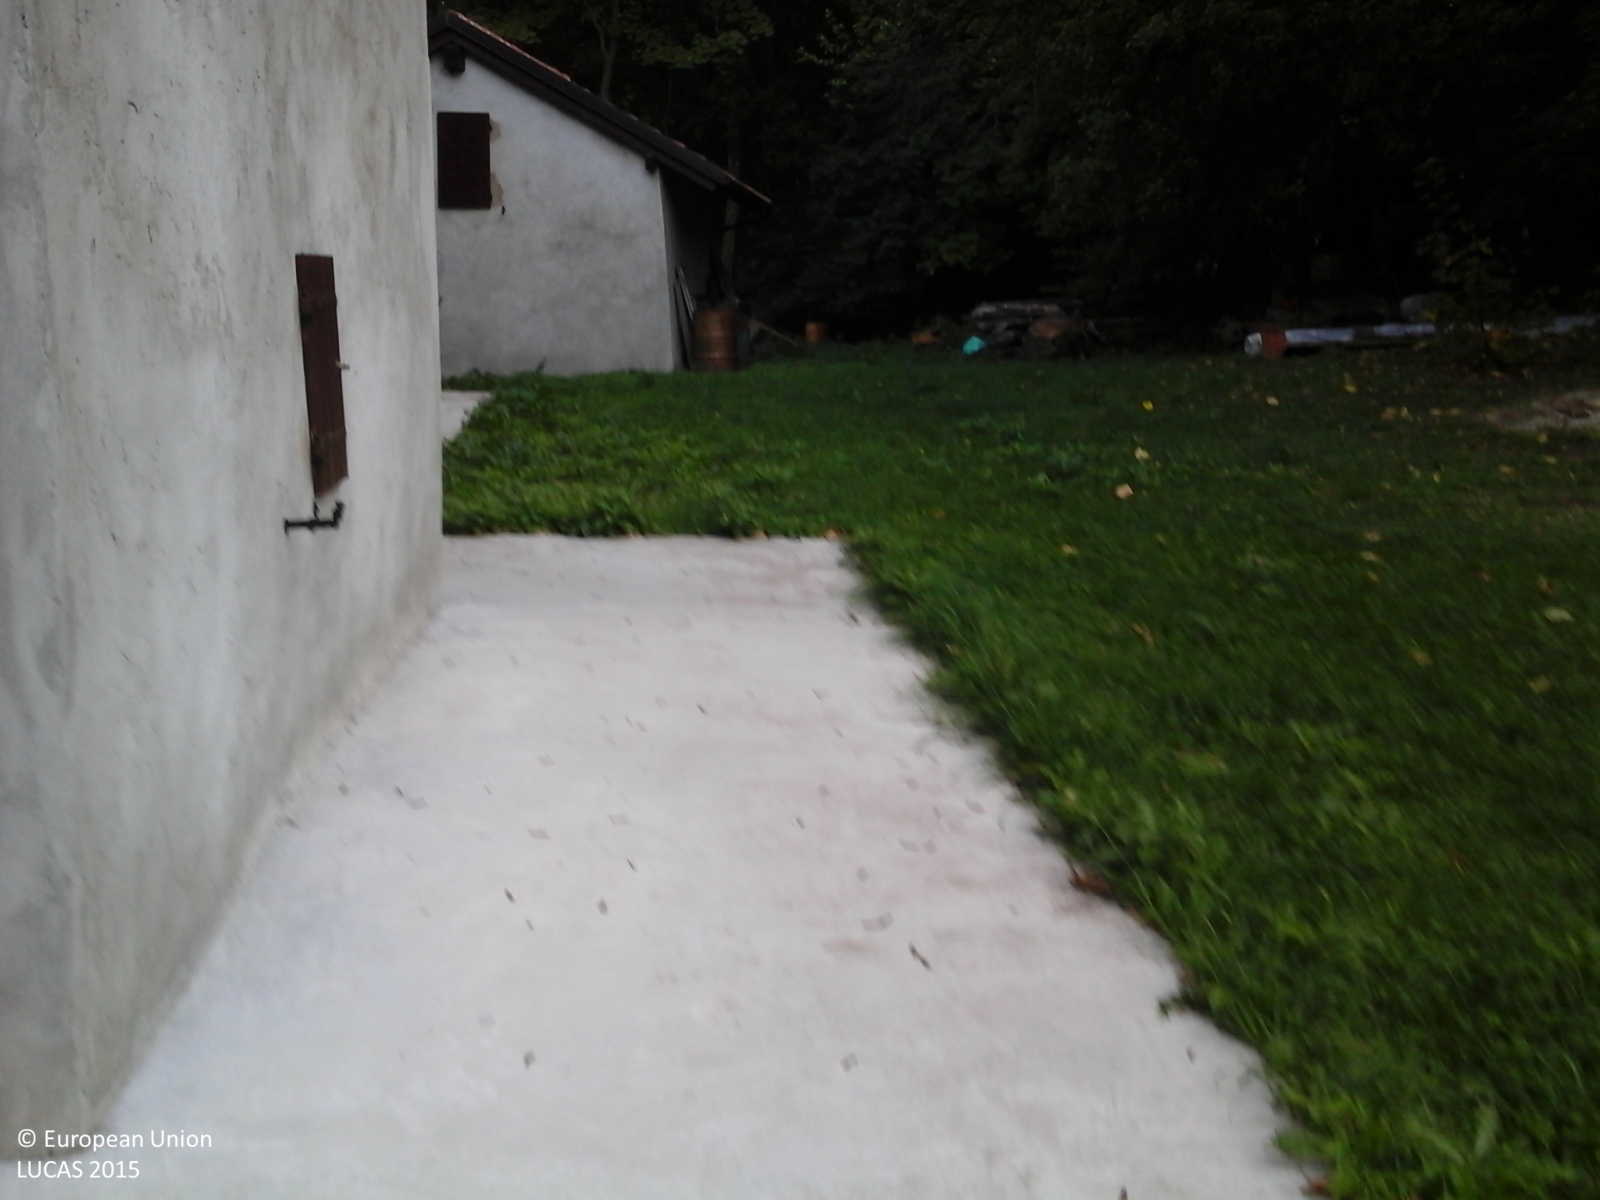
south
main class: Grassland
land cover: Grassland with sparse tree/shrub cover
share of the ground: > 75 %
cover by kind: herbaceous plants 85 %, shrubs 10 %, broadleaved forest trees 5 %
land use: Residential
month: September
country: IT
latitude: 44.4105
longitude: 8.4087
